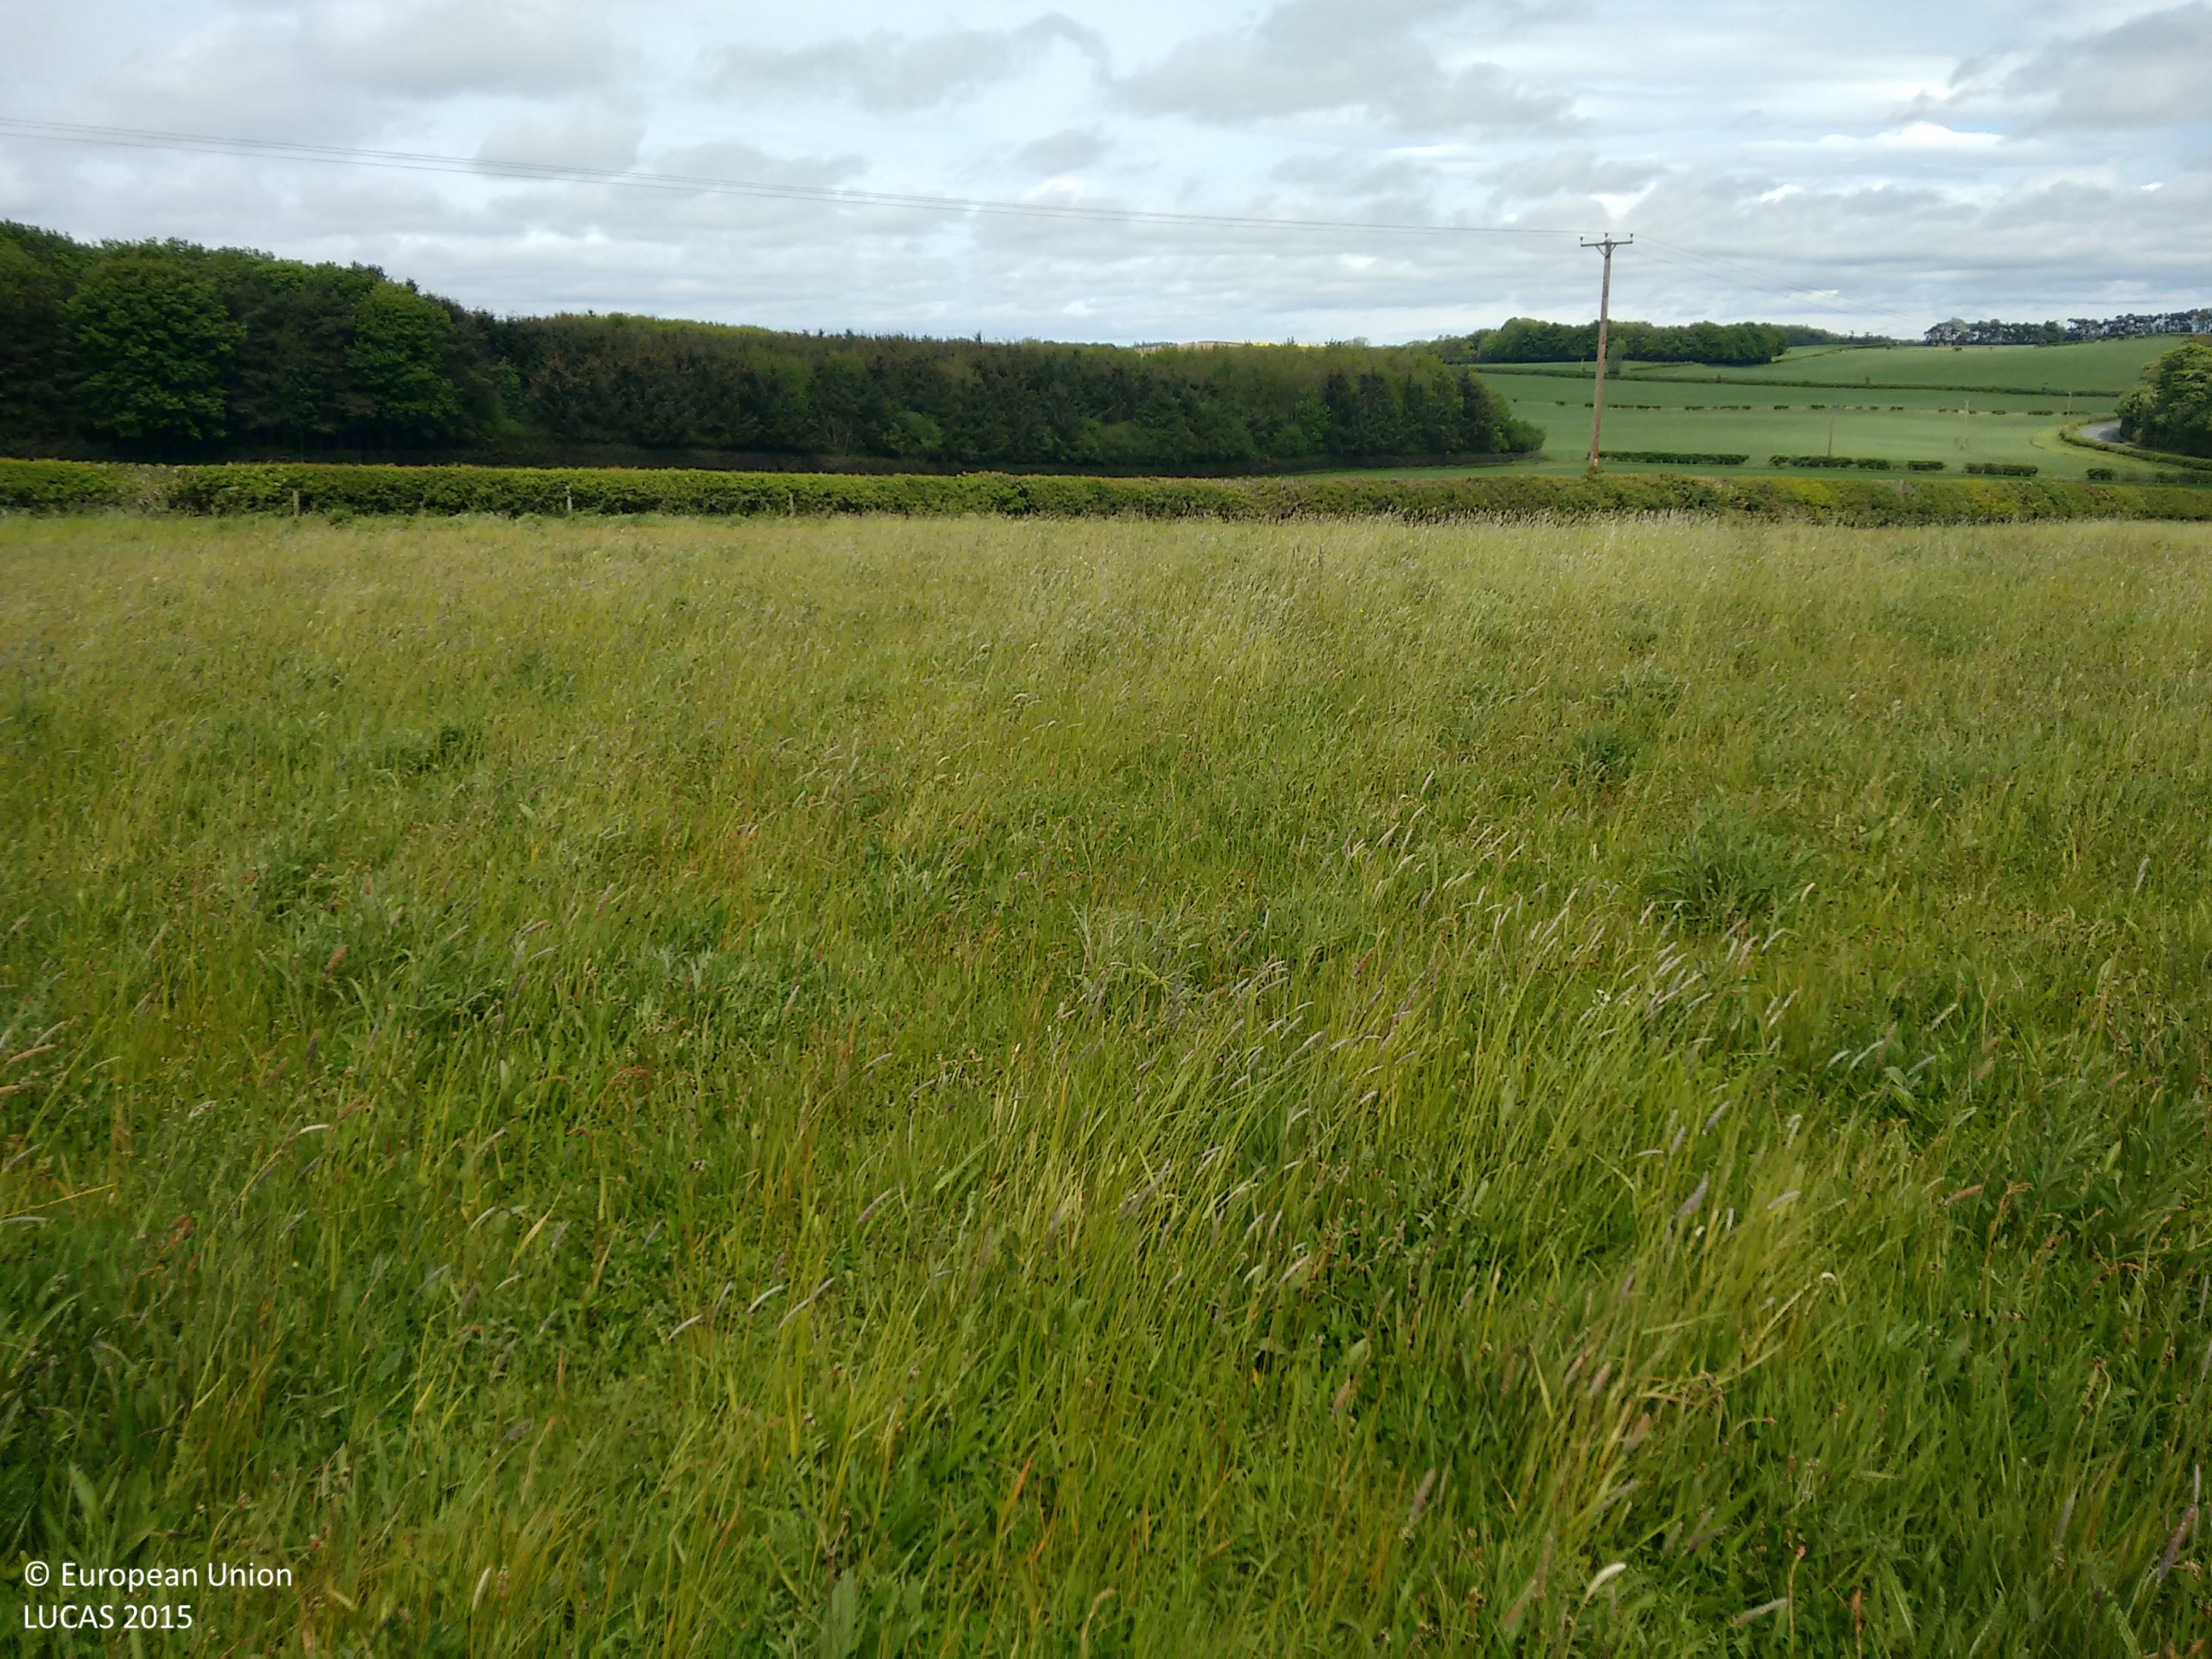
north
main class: Grassland
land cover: Grassland without tree/shrub cover
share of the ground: > 75 %
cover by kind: herbaceous plants 100 %
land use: Agriculture (excluding fallow land and kitchen gardens)
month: May
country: GB
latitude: 55.6201
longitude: -2.3970
